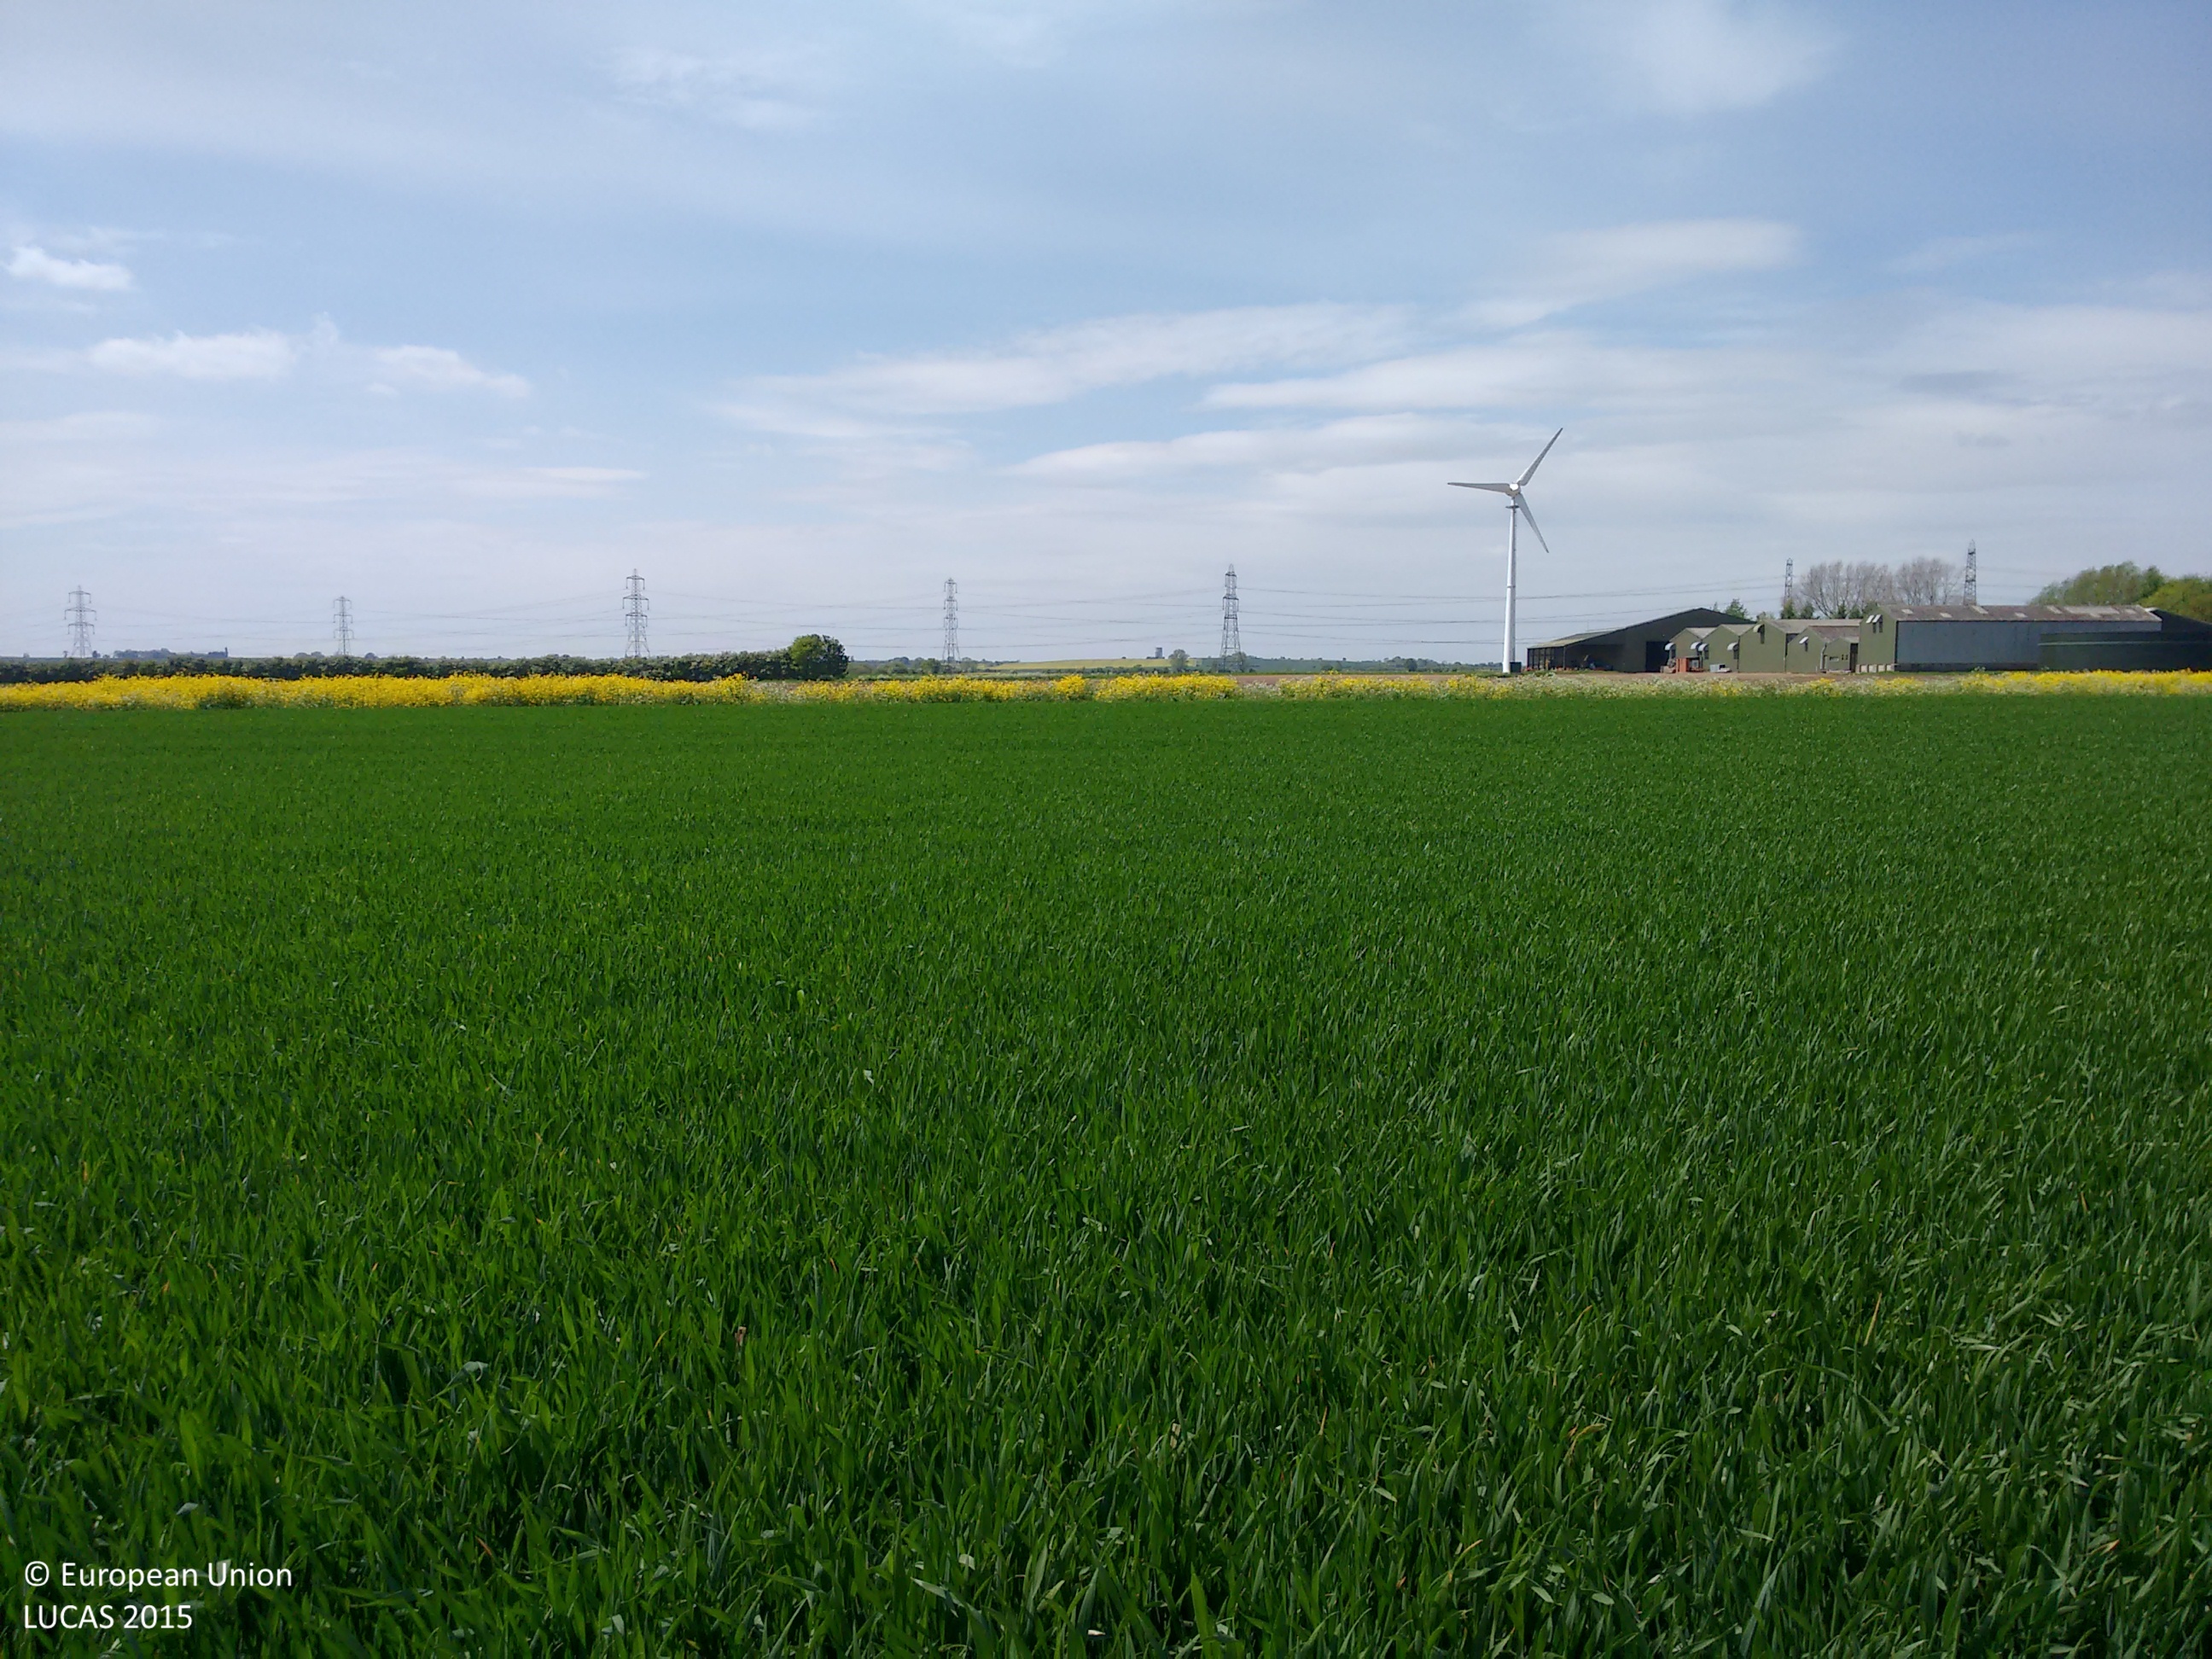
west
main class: Cropland
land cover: Common wheat
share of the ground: > 75 %
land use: Agriculture (excluding fallow land and kitchen gardens)
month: May
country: GB
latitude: 53.5372
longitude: -0.7684
